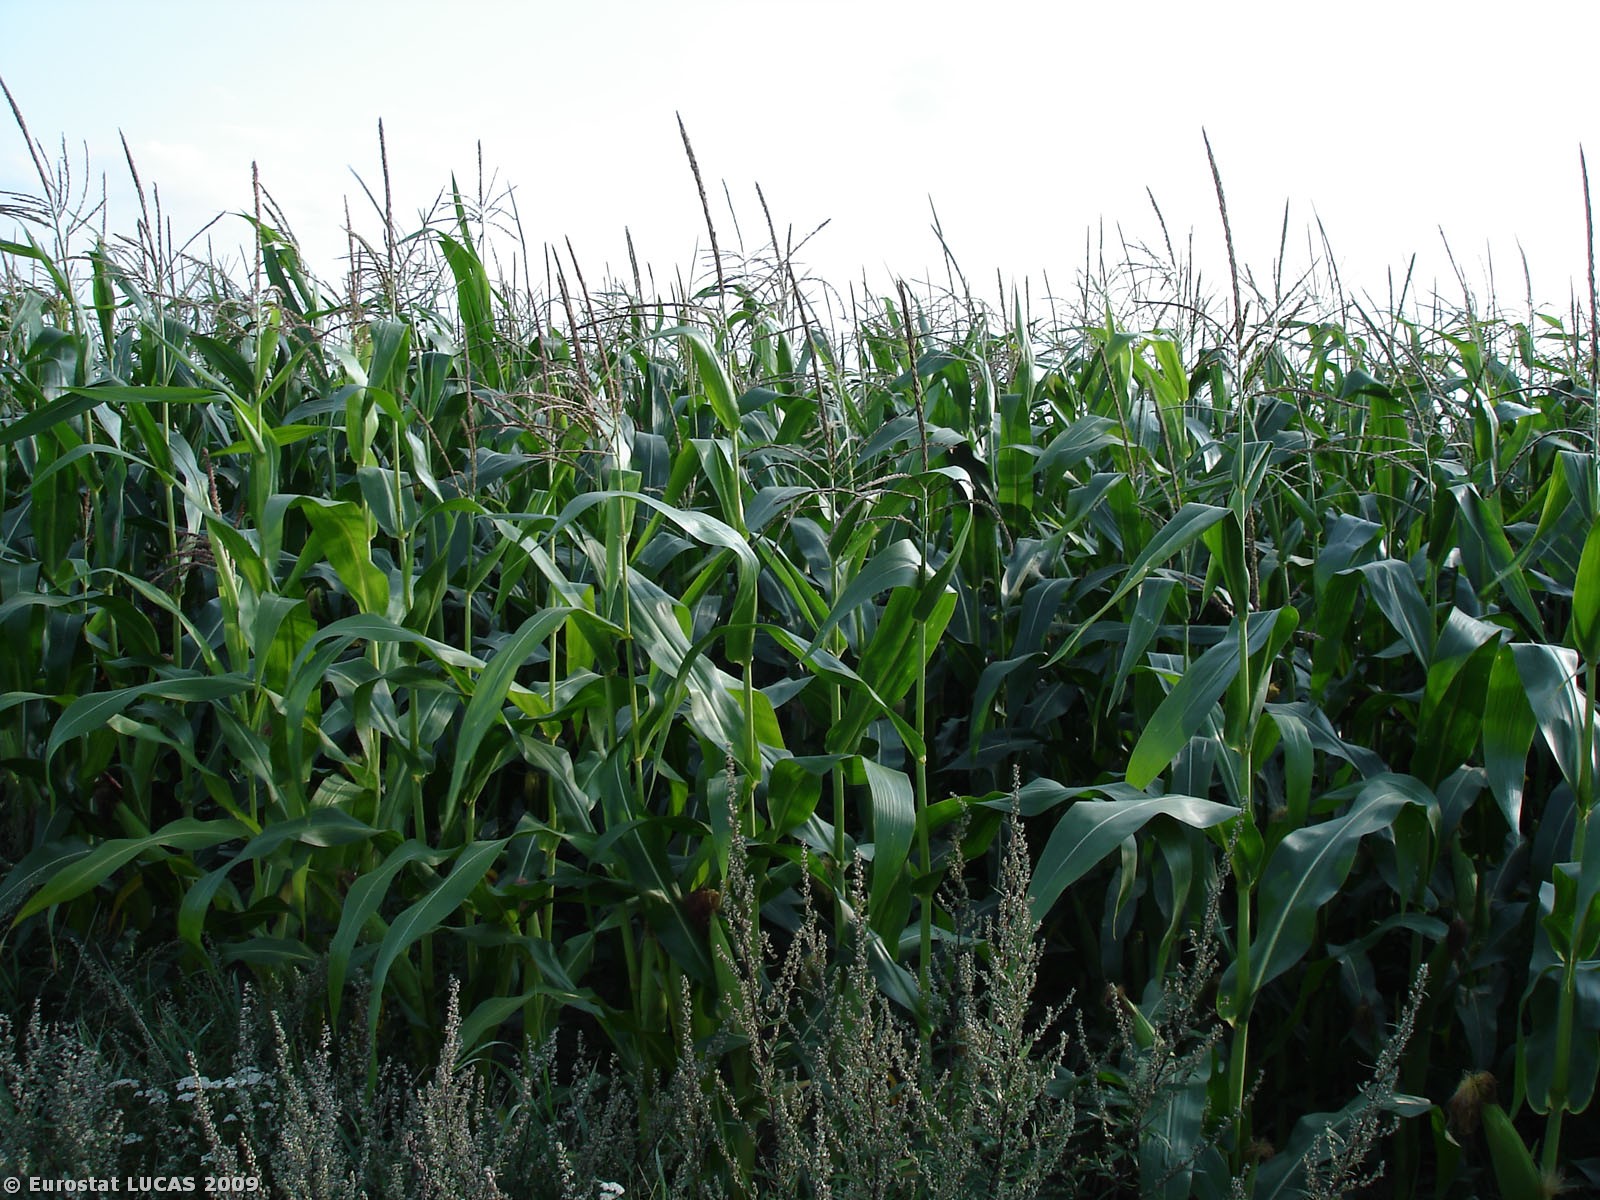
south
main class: Cropland
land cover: Maize
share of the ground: > 75 %
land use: Agriculture (excluding fallow land and kitchen gardens)
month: August
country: PL
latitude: 50.9844
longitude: 18.2942
